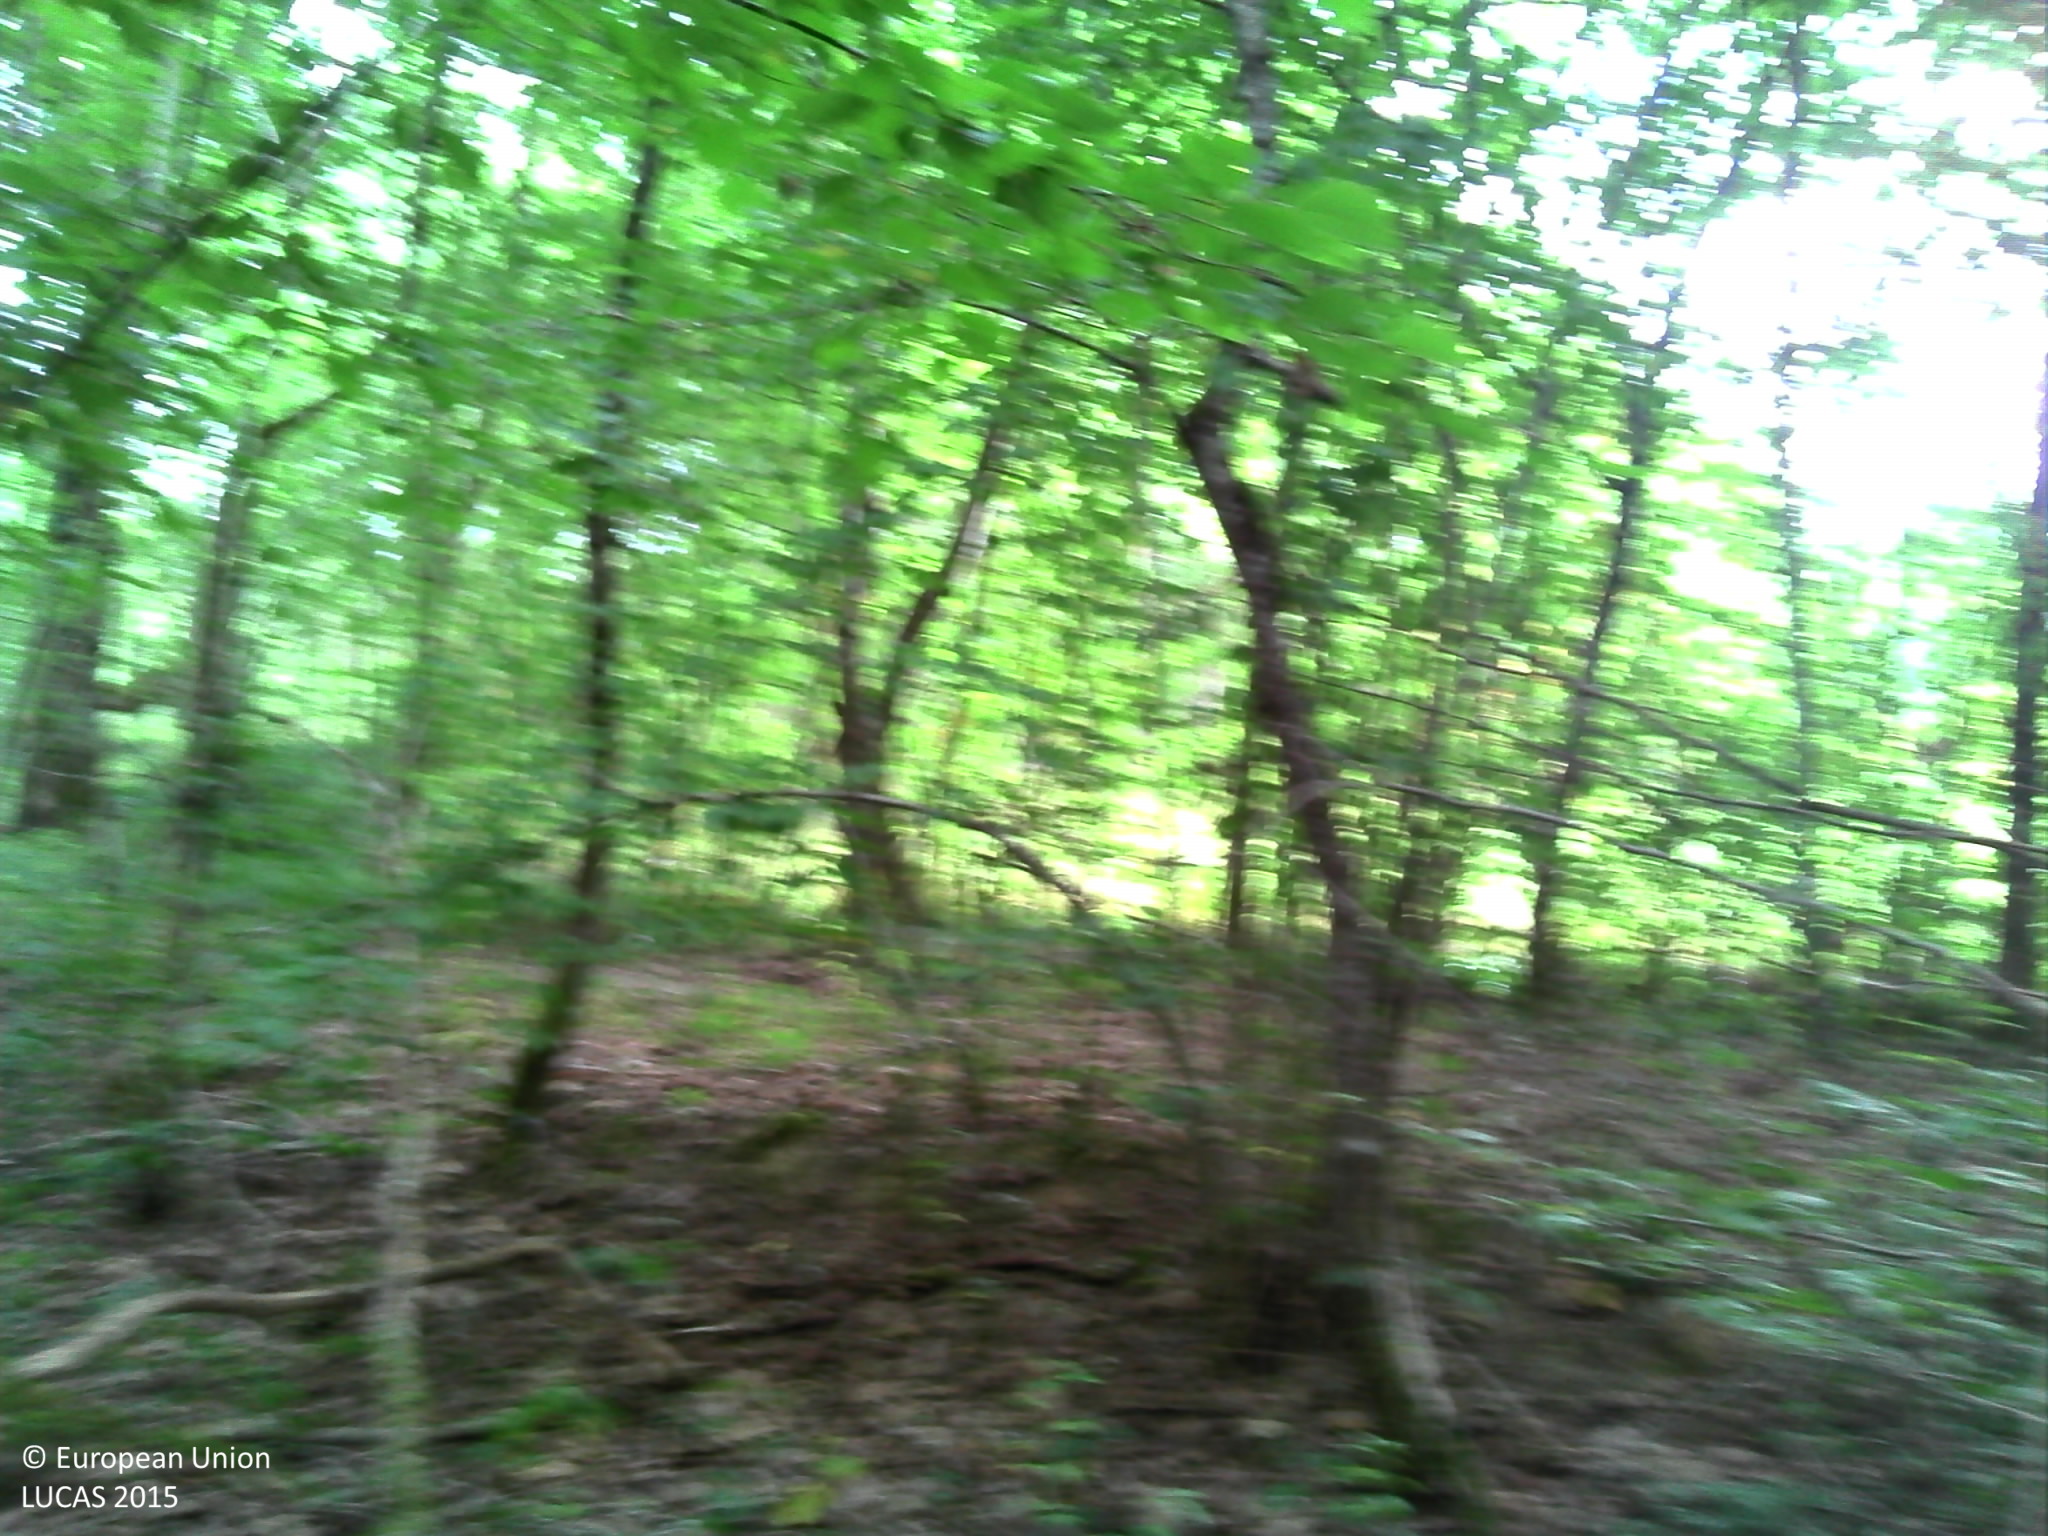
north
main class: Woodland
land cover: Broadleaved woodland
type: mesophytic deciduous forest
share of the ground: > 75 %
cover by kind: broadleaved forest trees 100 %
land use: Forestry
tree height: > 5 m
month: July
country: FR
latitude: 46.7363
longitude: 3.2838
